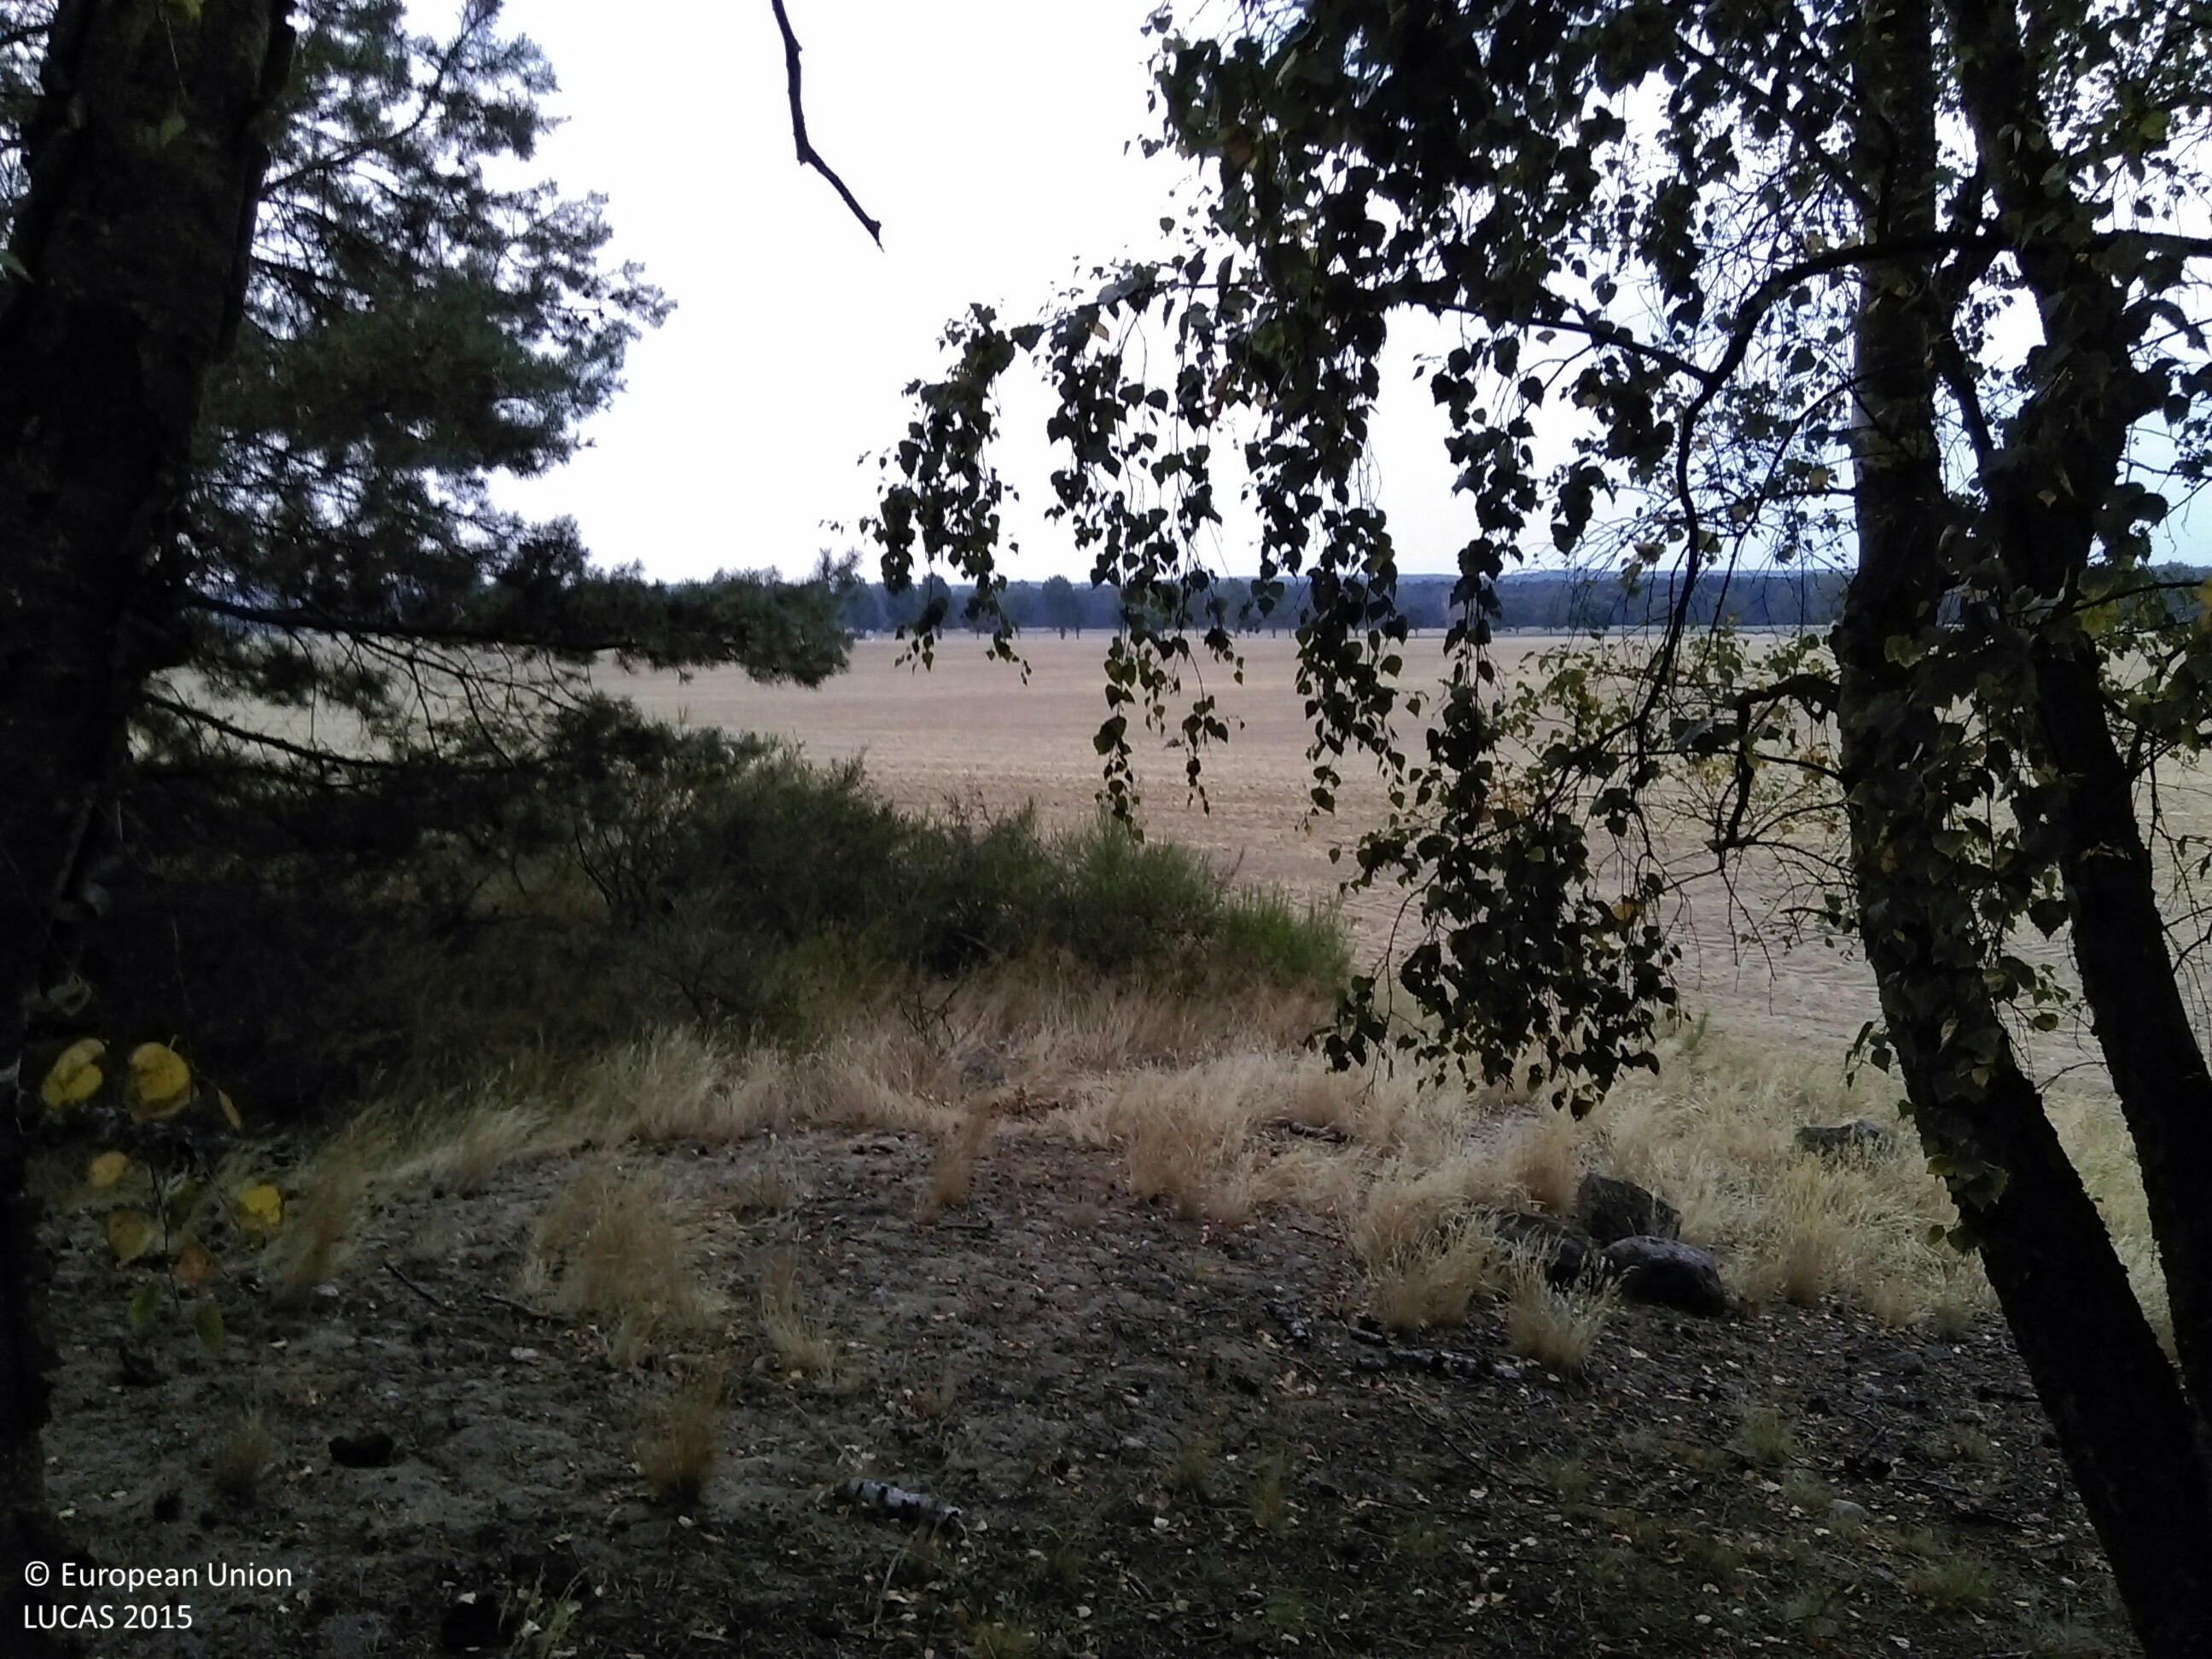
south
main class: Woodland
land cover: Pine dominated mixed woodland
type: hemiboreal forest and nemoral coniferous forest and mixed broadleaved-coniferous forest
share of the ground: 50 - 75 %
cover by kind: coniferous forest trees 40 %, broadleaved forest trees 30 %, herbaceous plants 15 %, unconsolidated bare surface 15 %
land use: Forestry
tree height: > 5 m
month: August
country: PL
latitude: 52.2805
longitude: 15.6183
